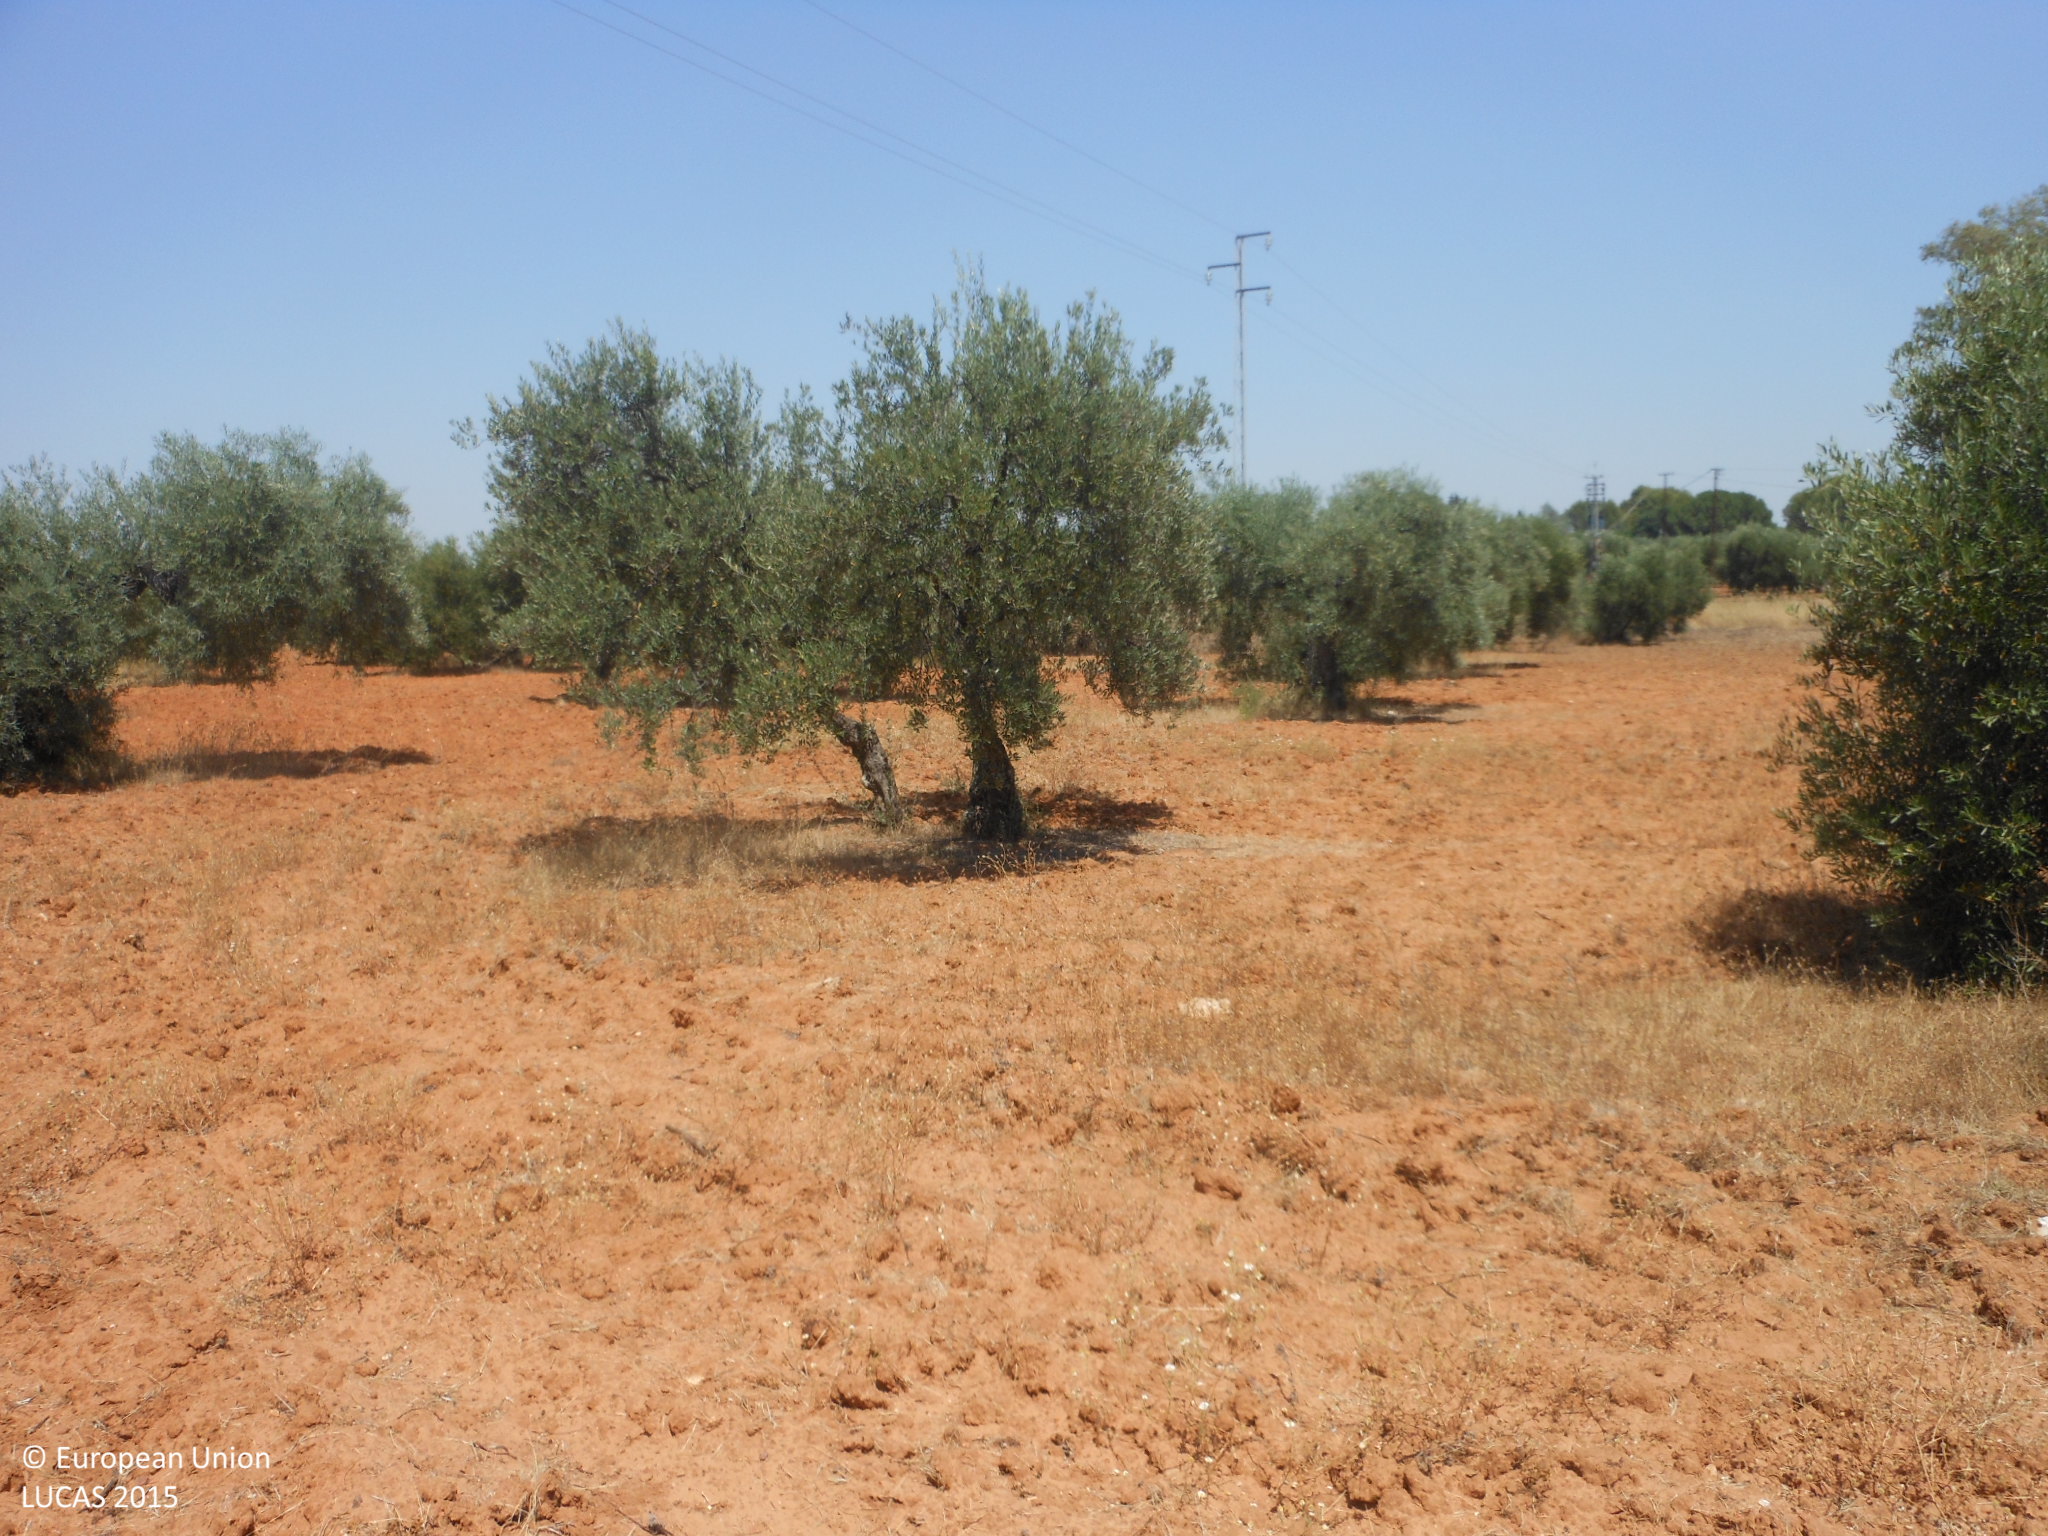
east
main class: Cropland
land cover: Olive groves
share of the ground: 25 - 50 %
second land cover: Other bare soil
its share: > 75 %
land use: Agriculture (excluding fallow land and kitchen gardens)
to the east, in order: Olive groves; Other bare soil; Electric lines; Olive groves; Tracks; Olive groves; Electric lines; Olive groves
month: June
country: ES
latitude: 37.2153
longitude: -5.4389
